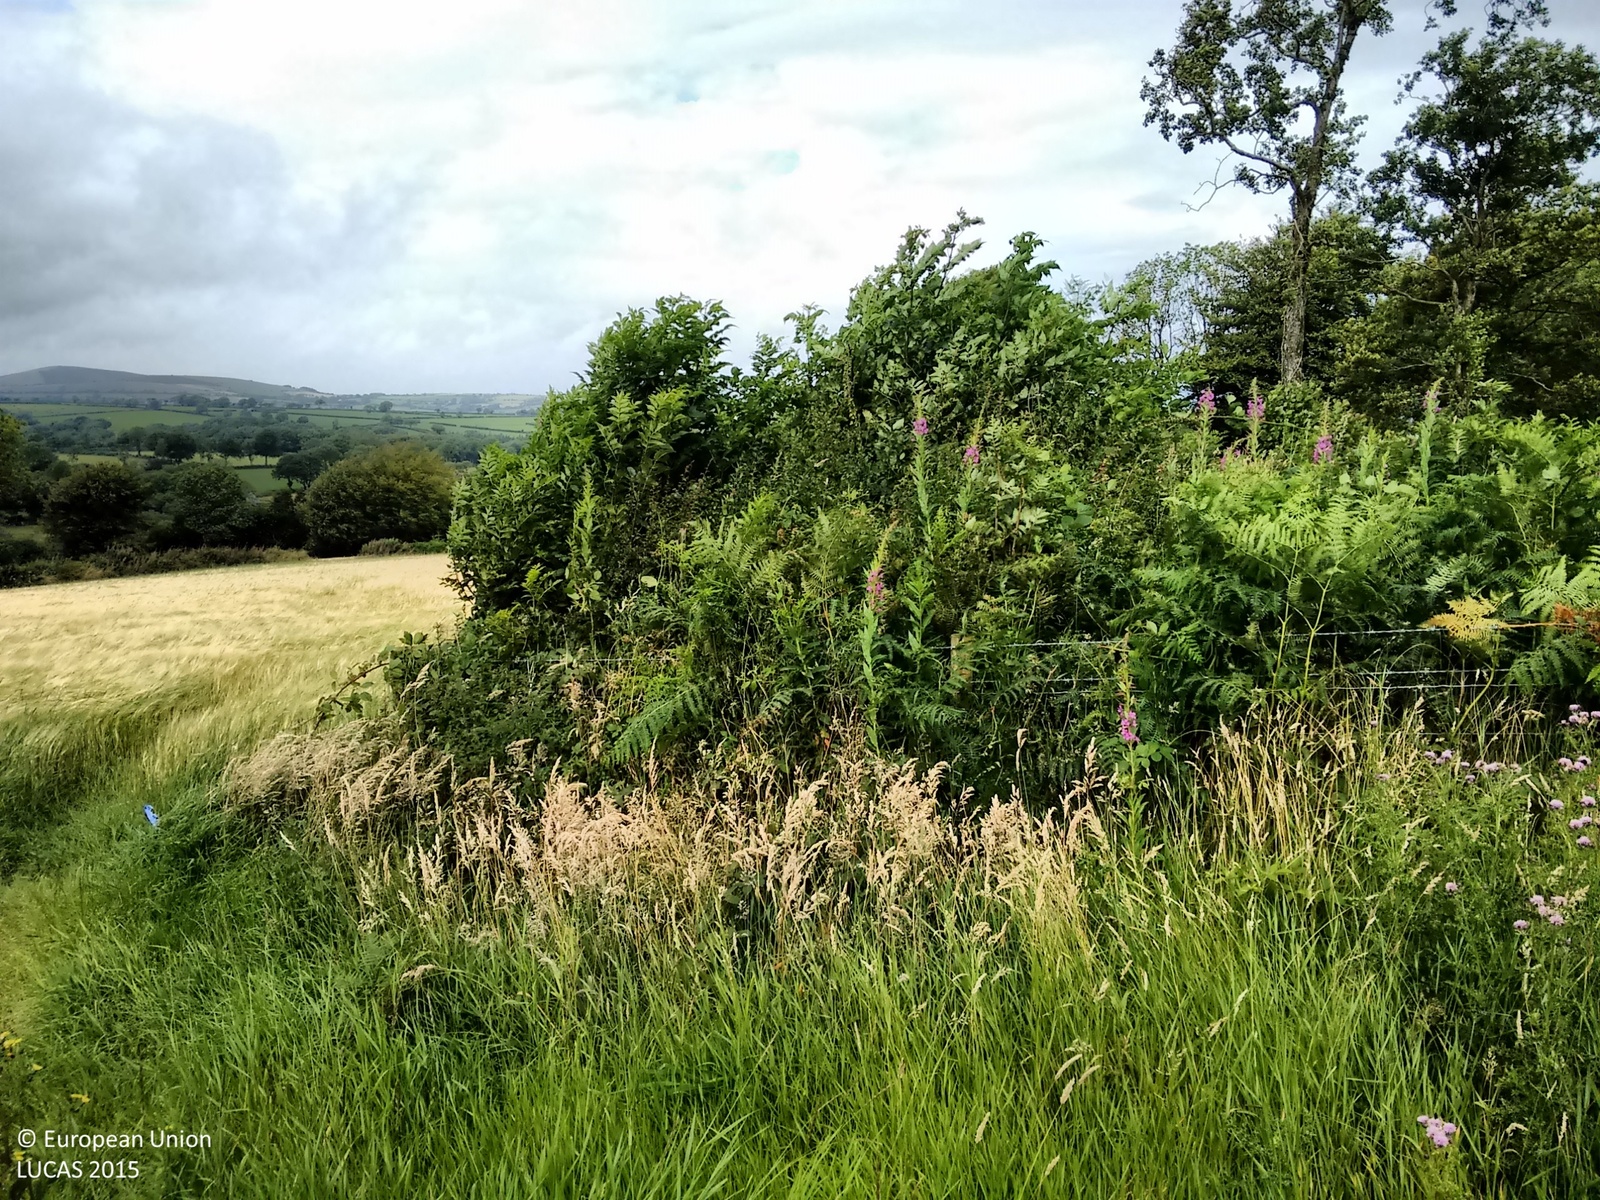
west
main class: Cropland
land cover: Barley
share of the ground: > 75 %
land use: Agriculture (excluding fallow land and kitchen gardens)
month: August
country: GB
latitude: 51.9739
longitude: -4.5028
